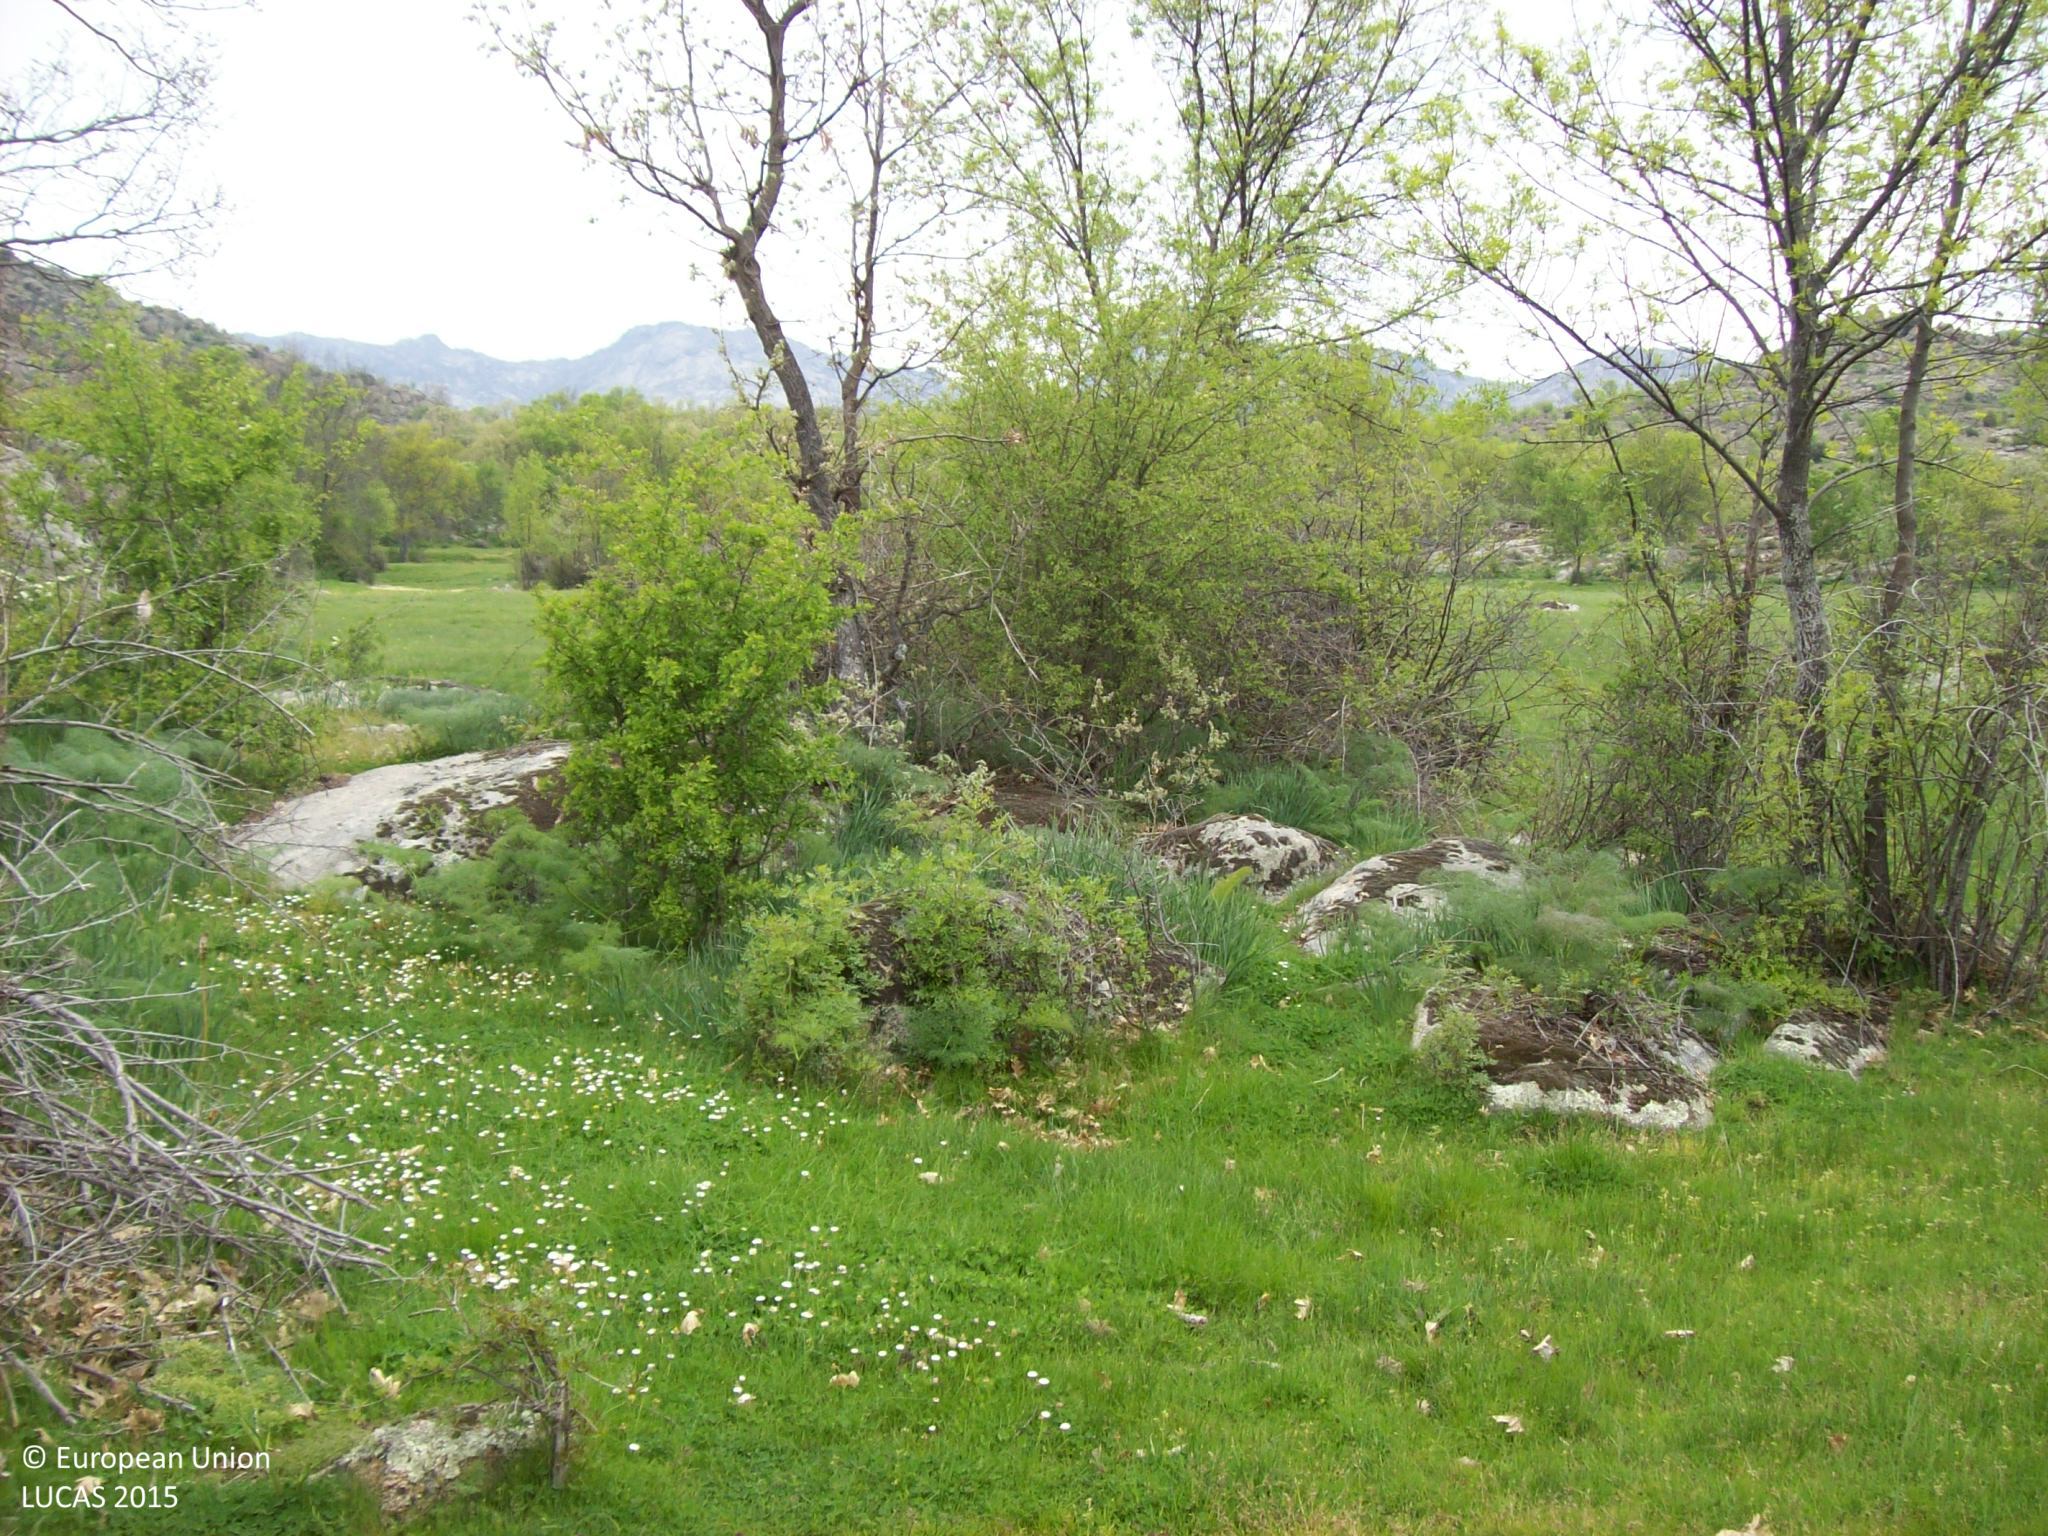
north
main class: Woodland
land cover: Broadleaved woodland
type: acidophilous oak and oak-birch forest
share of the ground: 10 - 25 %
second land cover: Grassland without tree/shrub cover
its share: > 75 %
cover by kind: herbaceous plants 40 %, consolidated bare surface 25 %, broadleaved forest trees 20 %, shrubs 15 %
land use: Forestry
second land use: Agriculture (excluding fallow land and kitchen gardens)
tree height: > 5 m
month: April
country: ES
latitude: 40.4372
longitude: -4.8259
